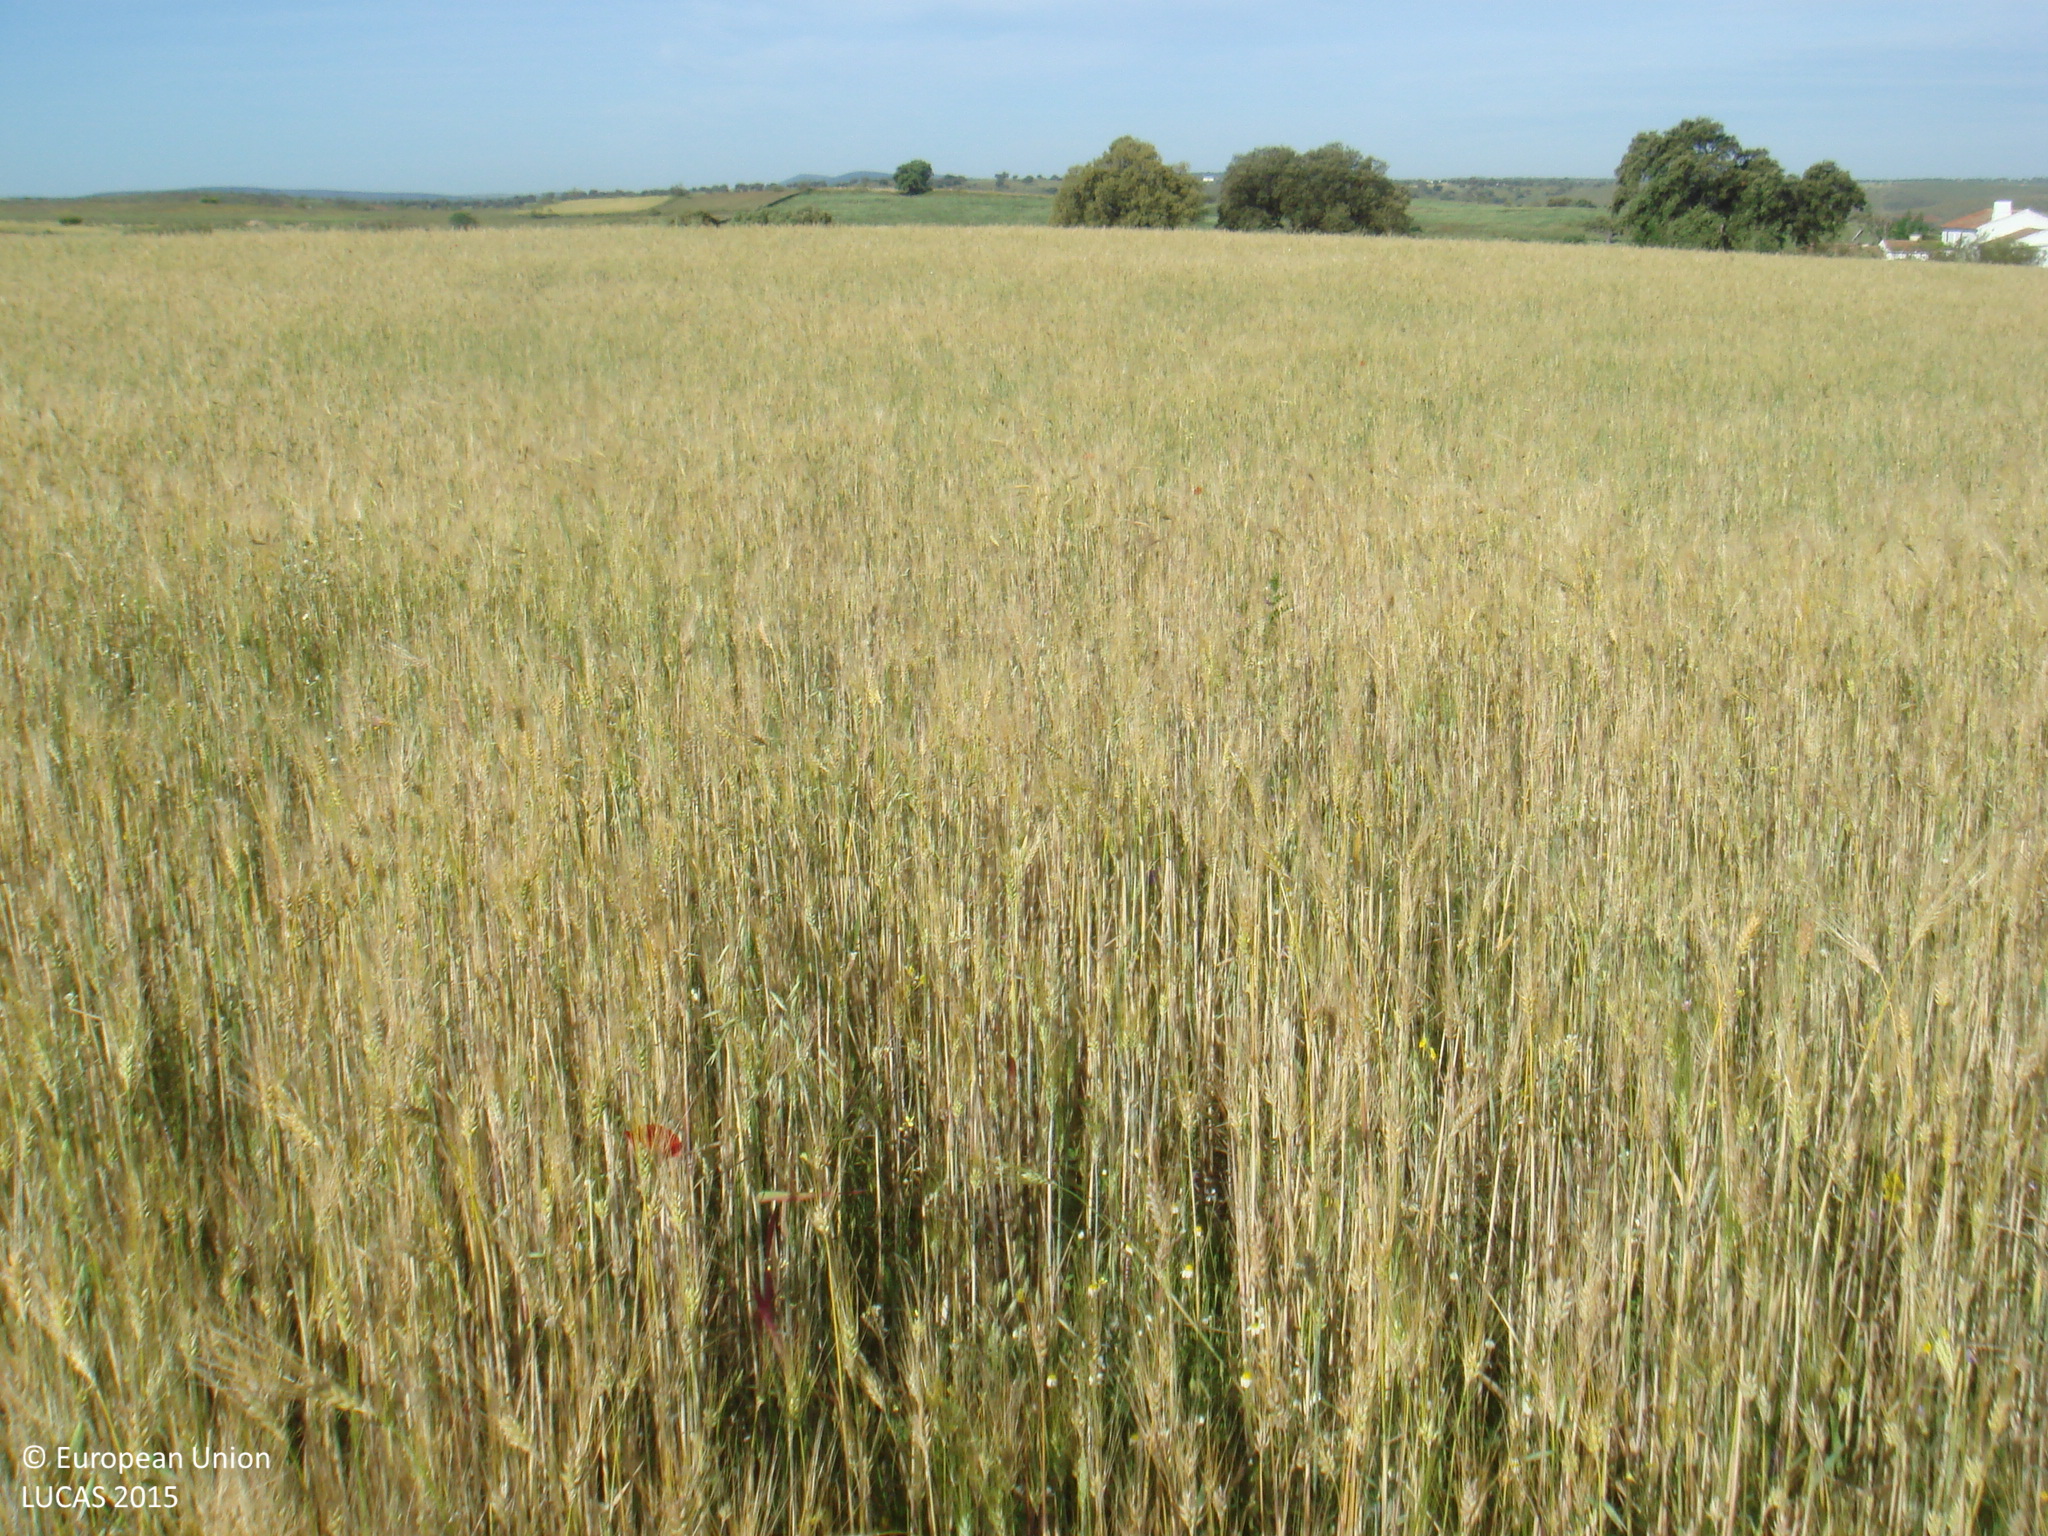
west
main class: Cropland
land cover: Durum wheat
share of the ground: > 75 %
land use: Agriculture (excluding fallow land and kitchen gardens)
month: May
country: ES
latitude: 38.4379
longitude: -5.0468
